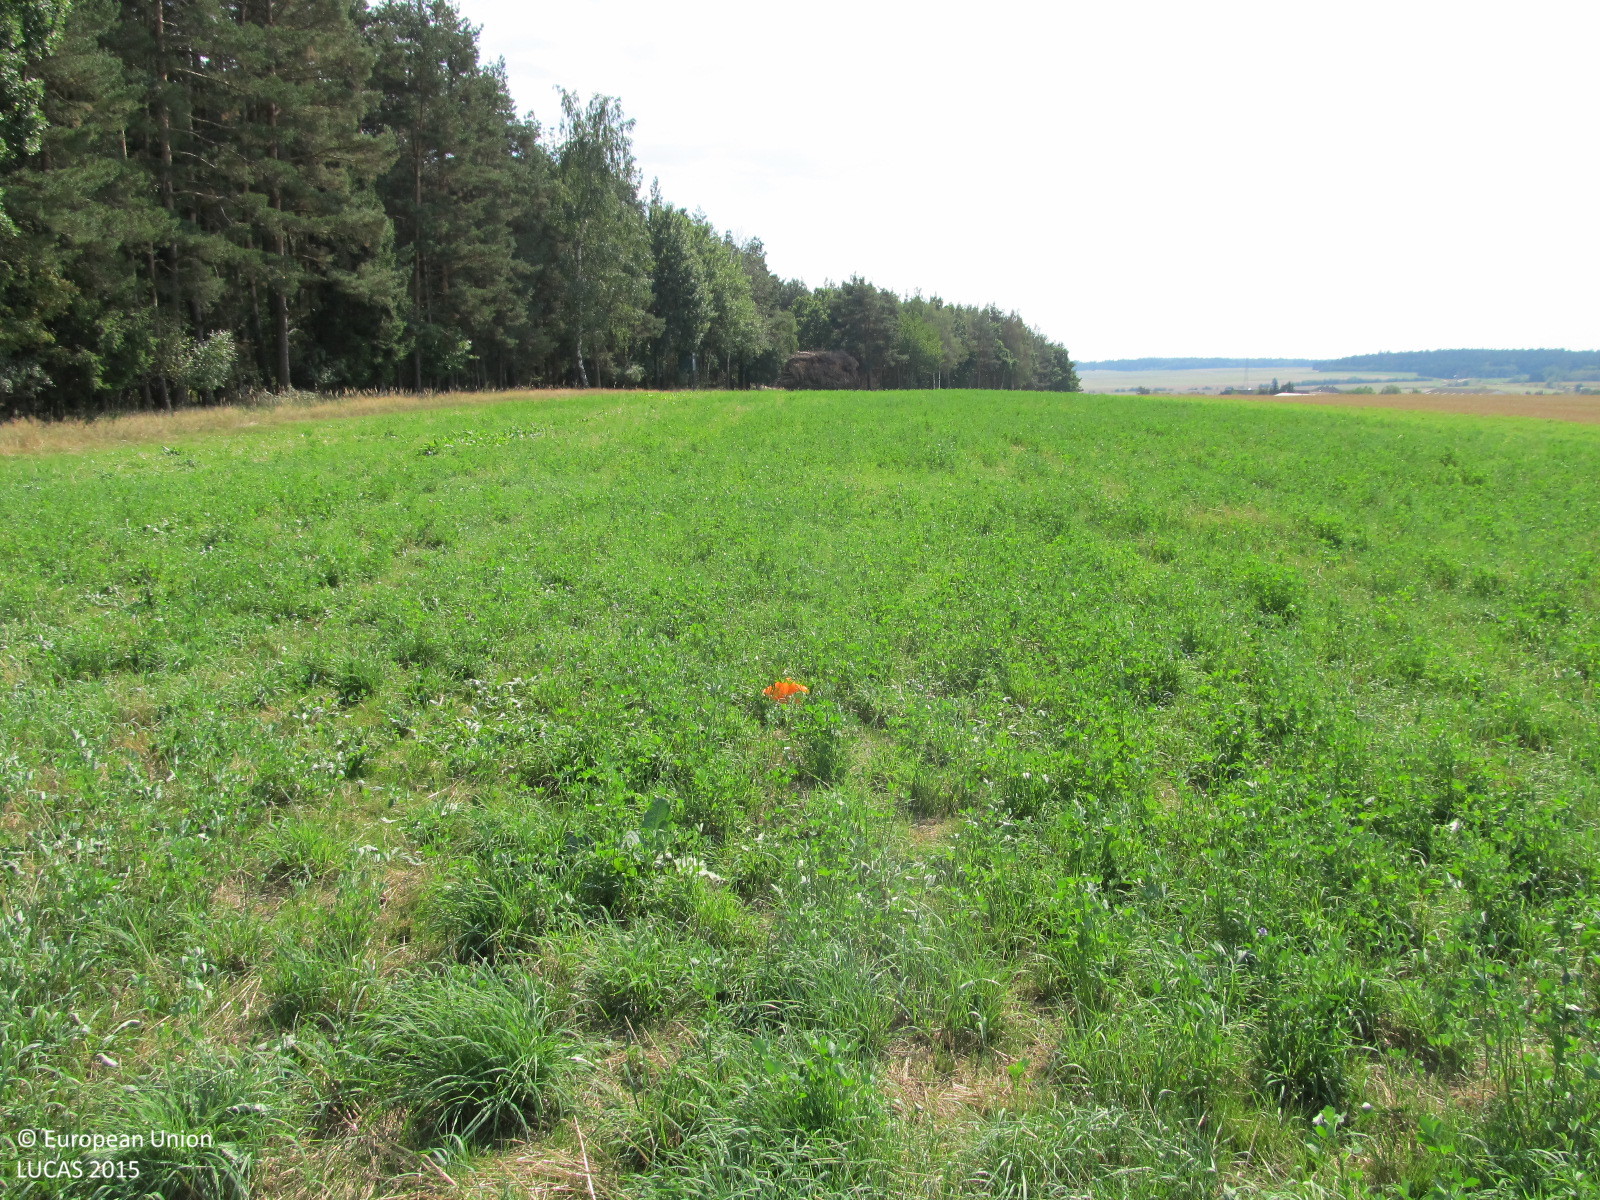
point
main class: Grassland
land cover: Grassland without tree/shrub cover
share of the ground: > 75 %
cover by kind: herbaceous plants 100 %
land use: Agriculture (excluding fallow land and kitchen gardens)
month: September
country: AT
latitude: 48.7655
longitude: 15.6223
